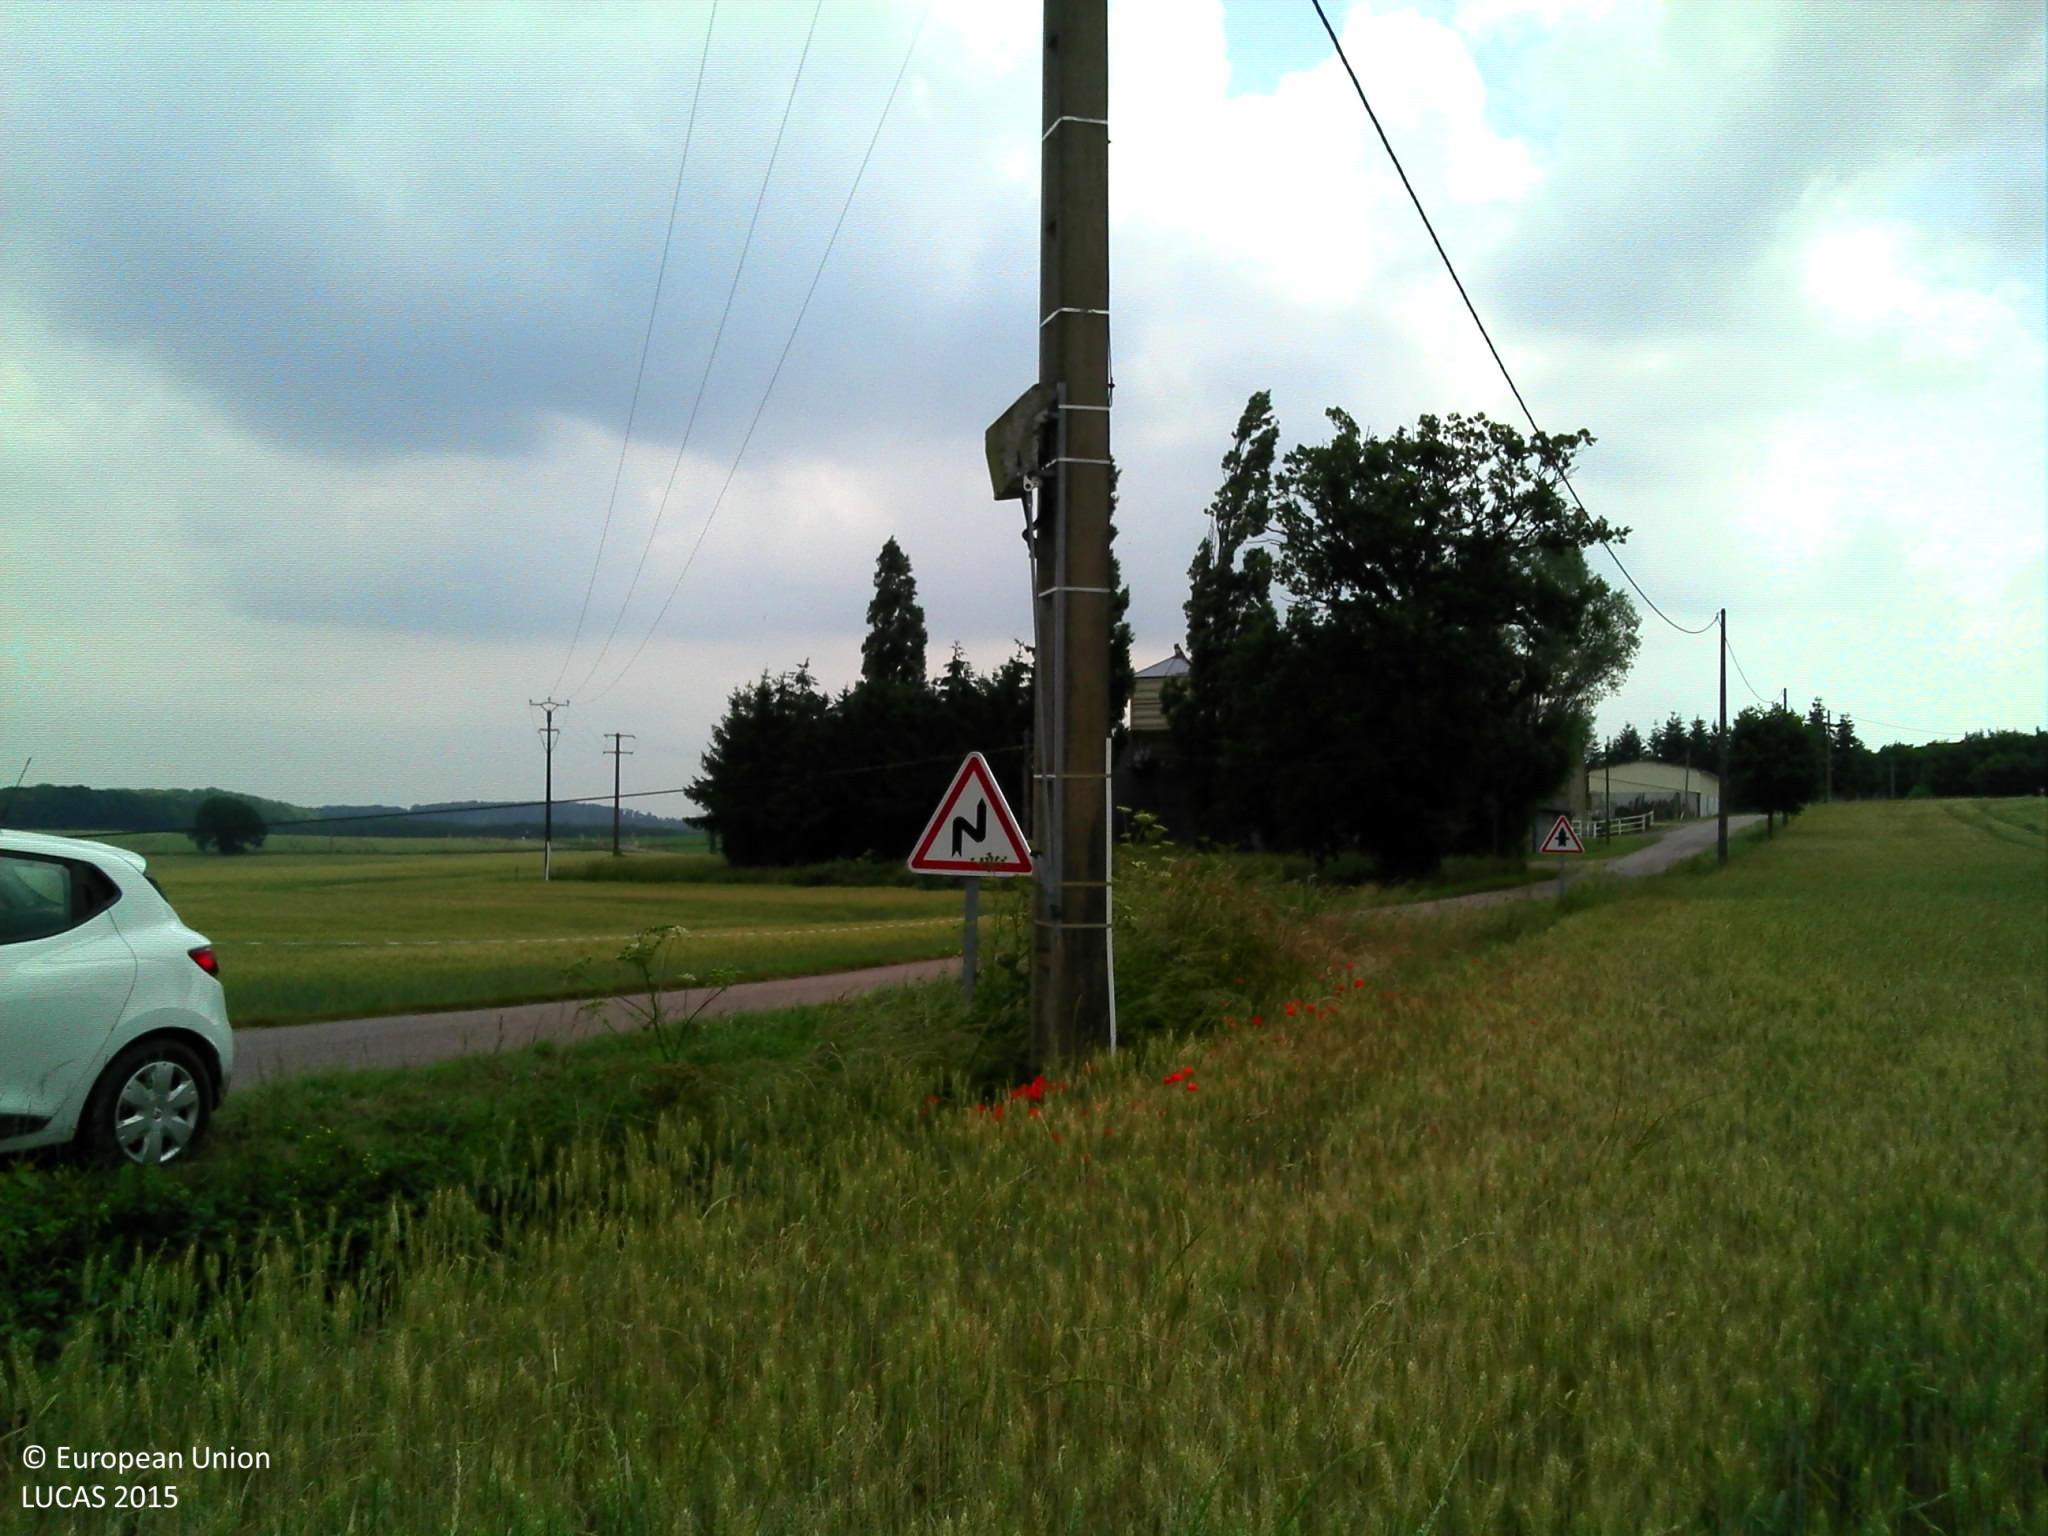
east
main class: Cropland
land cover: Common wheat
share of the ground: > 75 %
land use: Agriculture (excluding fallow land and kitchen gardens)
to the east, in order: Common wheat; Electric lines; Grass margins; Paved roads, cycling and walking lanes; Grass margins; Electric lines; Ditches and canals; Fences; Common wheat; Artificial constructions in urban areas; Common wheat
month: June
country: FR
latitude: 46.6077
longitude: 2.6973
